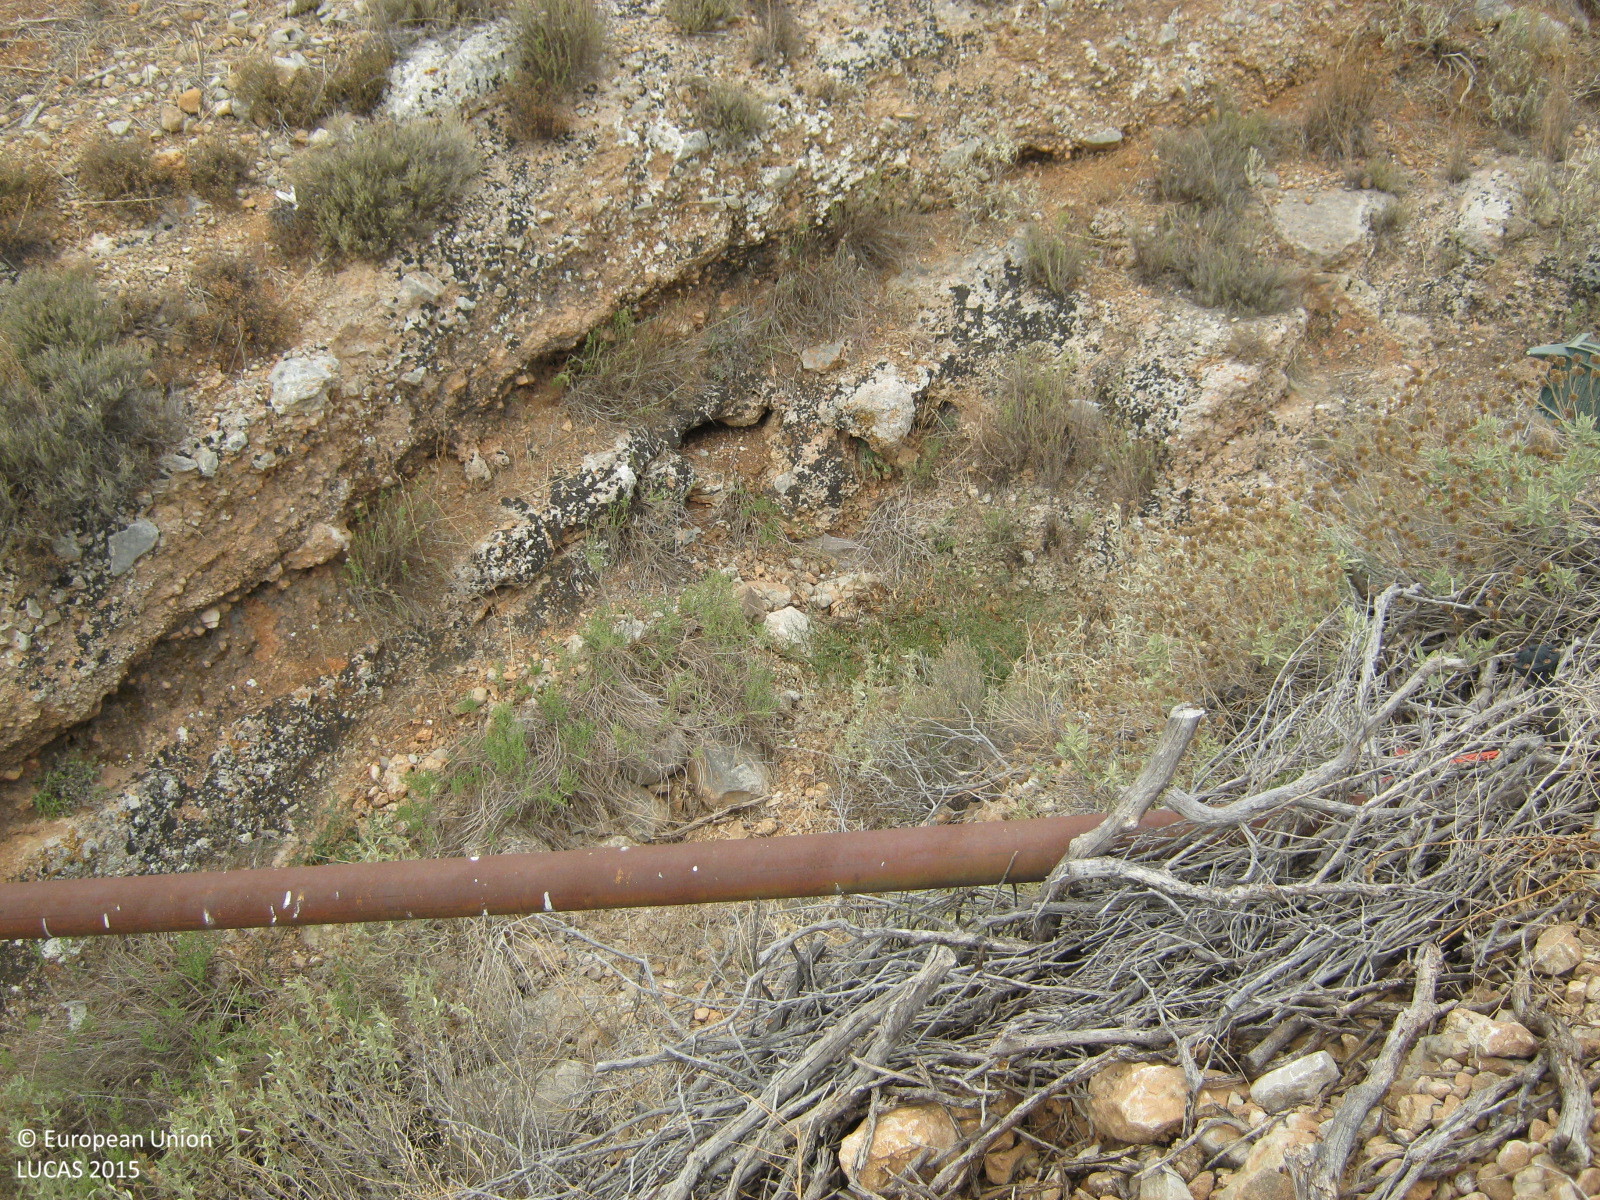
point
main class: Cropland
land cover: Oranges
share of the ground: > 75 %
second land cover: Spontaneously vegetated surfaces
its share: 50 - 75 %
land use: Agriculture (excluding fallow land and kitchen gardens)
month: August
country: GR
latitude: 37.6864
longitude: 22.7927
